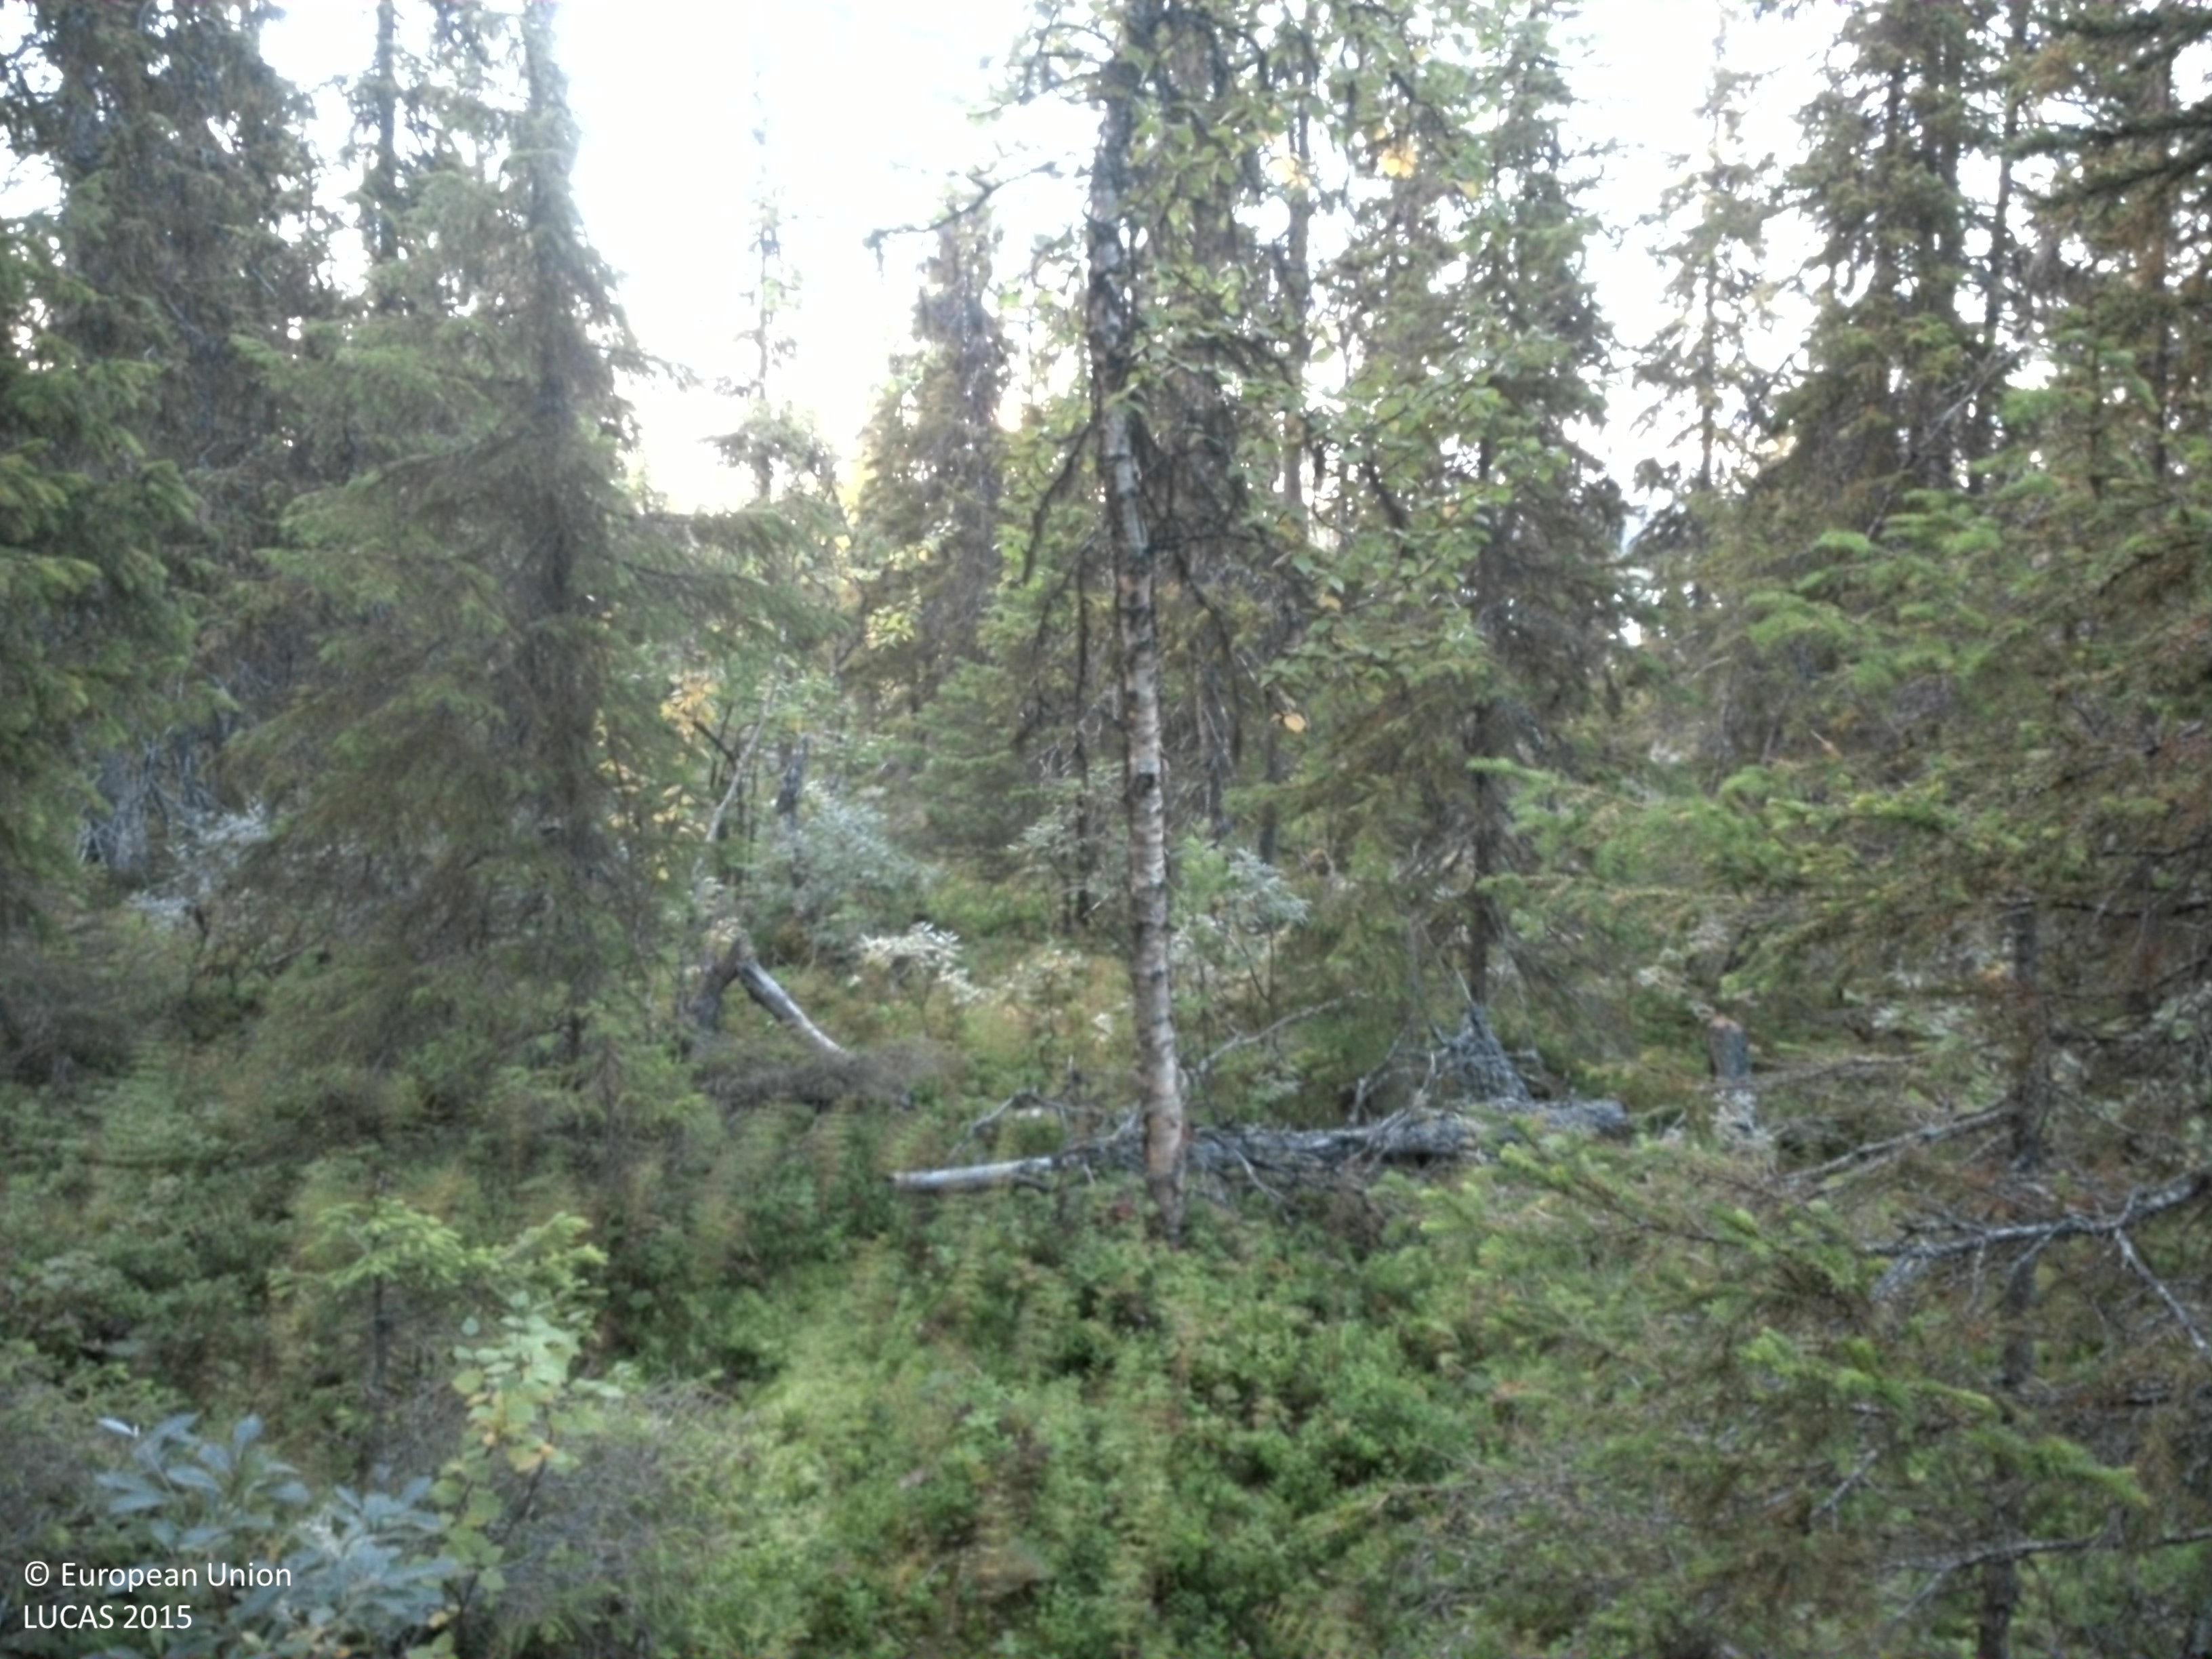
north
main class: Woodland
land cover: Spruce dominated coniferous woodland
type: boreal forest
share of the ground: 25 - 50 %
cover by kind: coniferous forest trees 30 %, shrubs 25 %, herbaceous plants 20 %, lichens and mosses 20 %, broadleaved forest trees 5 %
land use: Amenities, museums, leisure
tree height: > 5 m
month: September
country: SE
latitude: 65.7267
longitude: 16.2174
